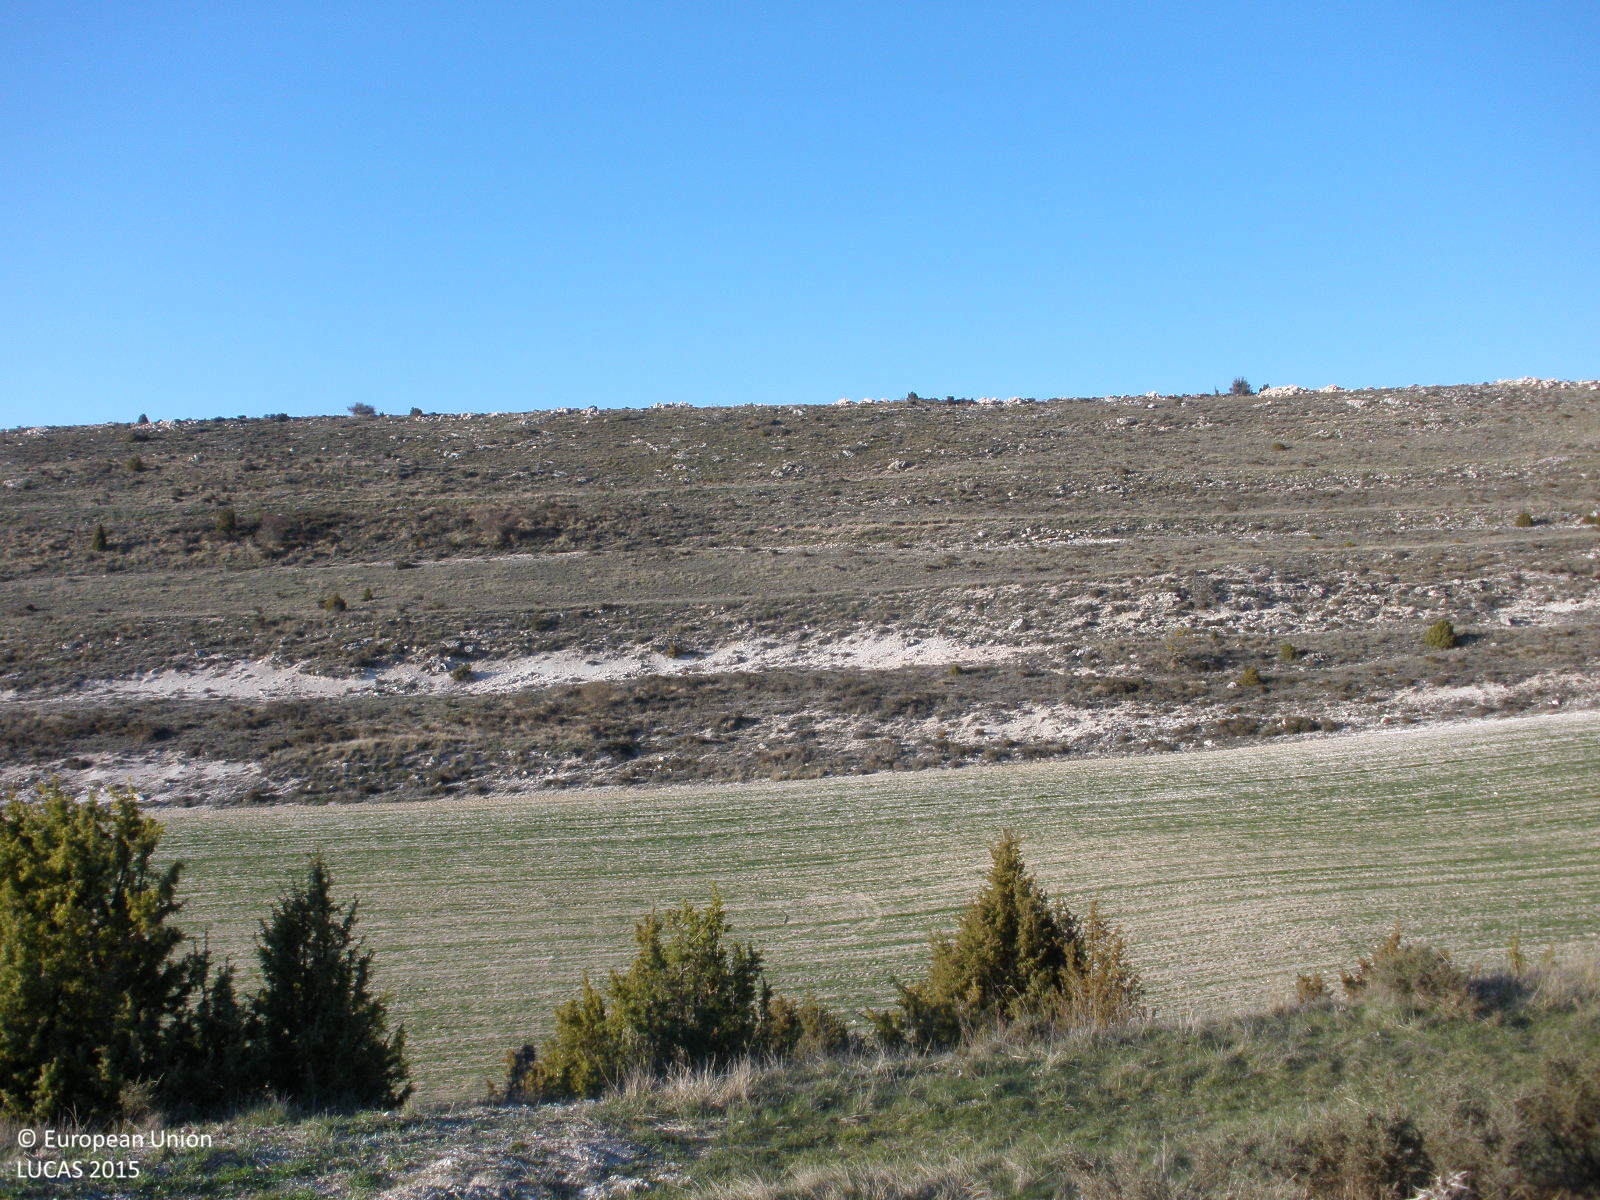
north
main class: Shrubland
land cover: Shrubland with sparse tree cover
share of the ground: > 75 %
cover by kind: shrubs 70 %, herbaceous plants 25 %, coniferous forest trees 5 %
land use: Agriculture (excluding fallow land and kitchen gardens)
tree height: < 5 m
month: April
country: ES
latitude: 40.8798
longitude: -1.0639
